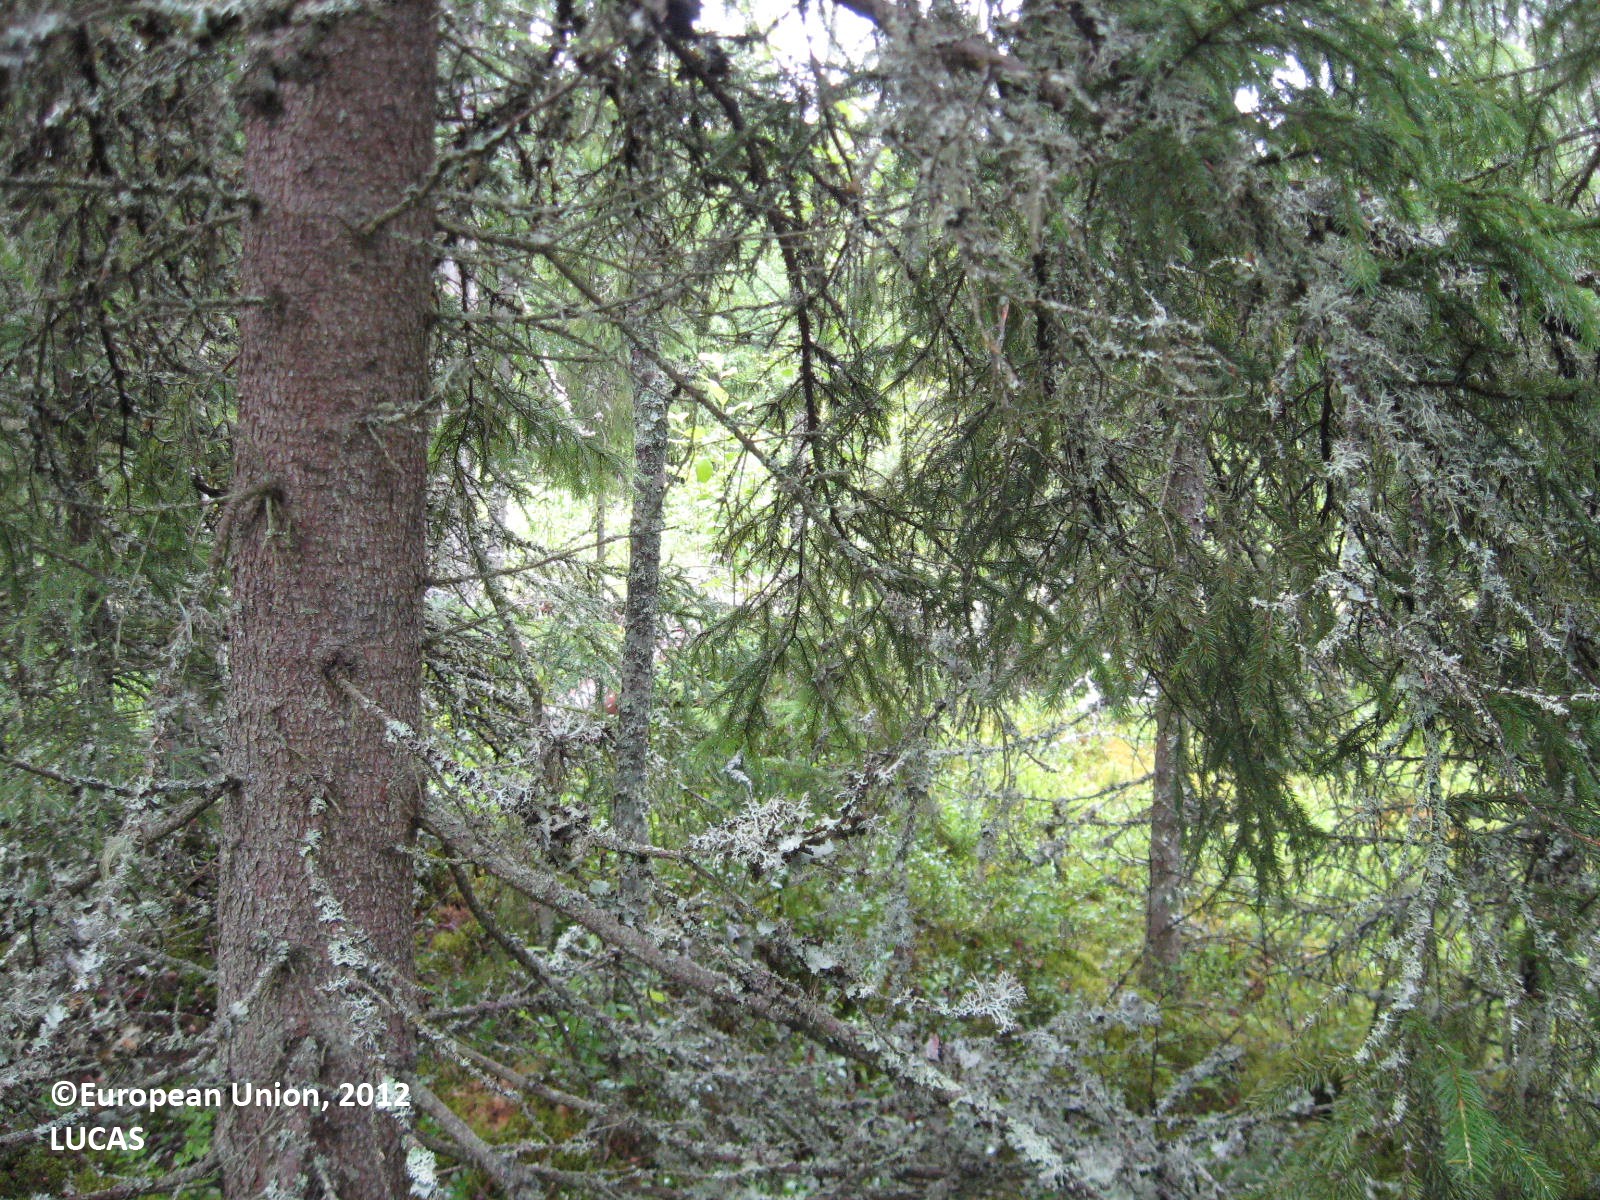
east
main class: Woodland
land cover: Pine dominated coniferous woodland
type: boreal forest
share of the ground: > 75 %
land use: Forestry
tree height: > 5 m
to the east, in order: Pine dominated coniferous woodland; Tracks; Other mixed woodland; Ditches and canals; Mixed cereals for fodder; Shruby margins; Ditches and canals; Tracks; Pine dominated coniferous woodland; Tracks; Oats
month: July
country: FI
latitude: 62.3425
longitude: 22.7477
